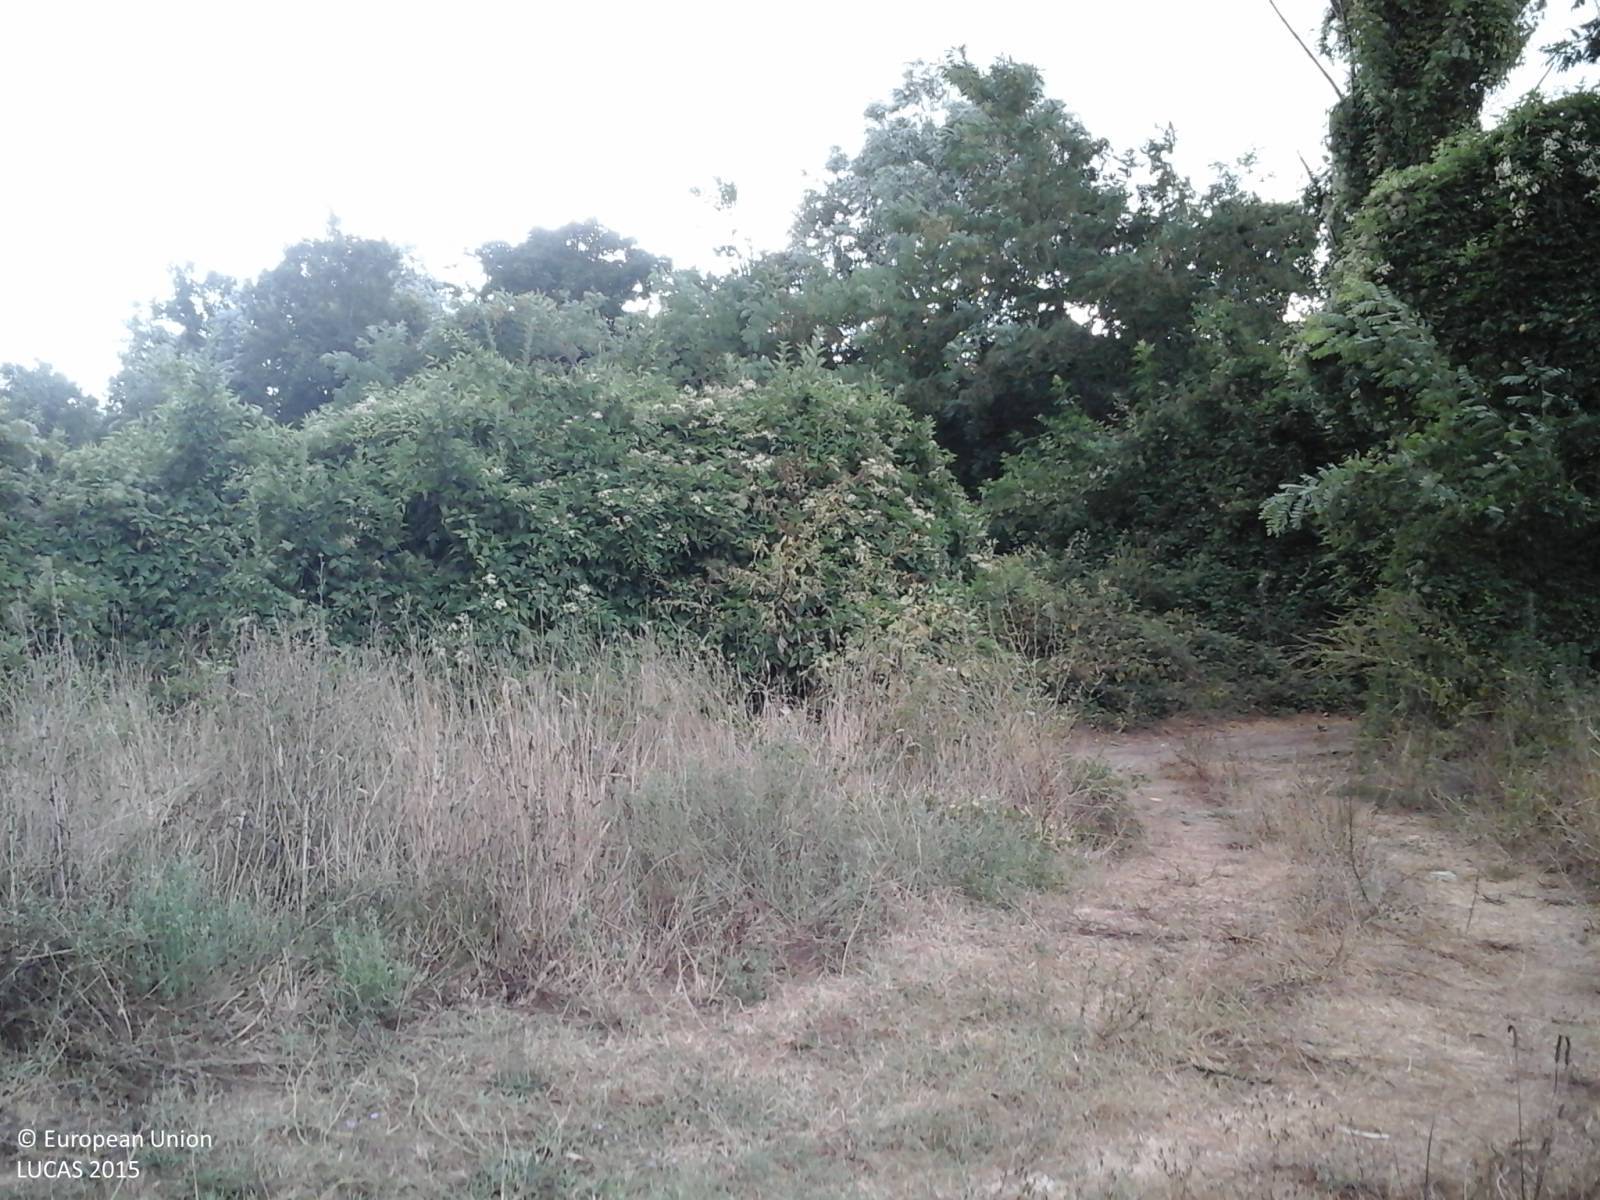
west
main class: Woodland
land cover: Broadleaved woodland
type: thermophilous deciduous forest
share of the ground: > 75 %
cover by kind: broadleaved forest trees 90 %, shrubs 10 %
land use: Forestry
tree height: > 5 m
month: July
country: IT
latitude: 41.9763
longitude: 12.3446
